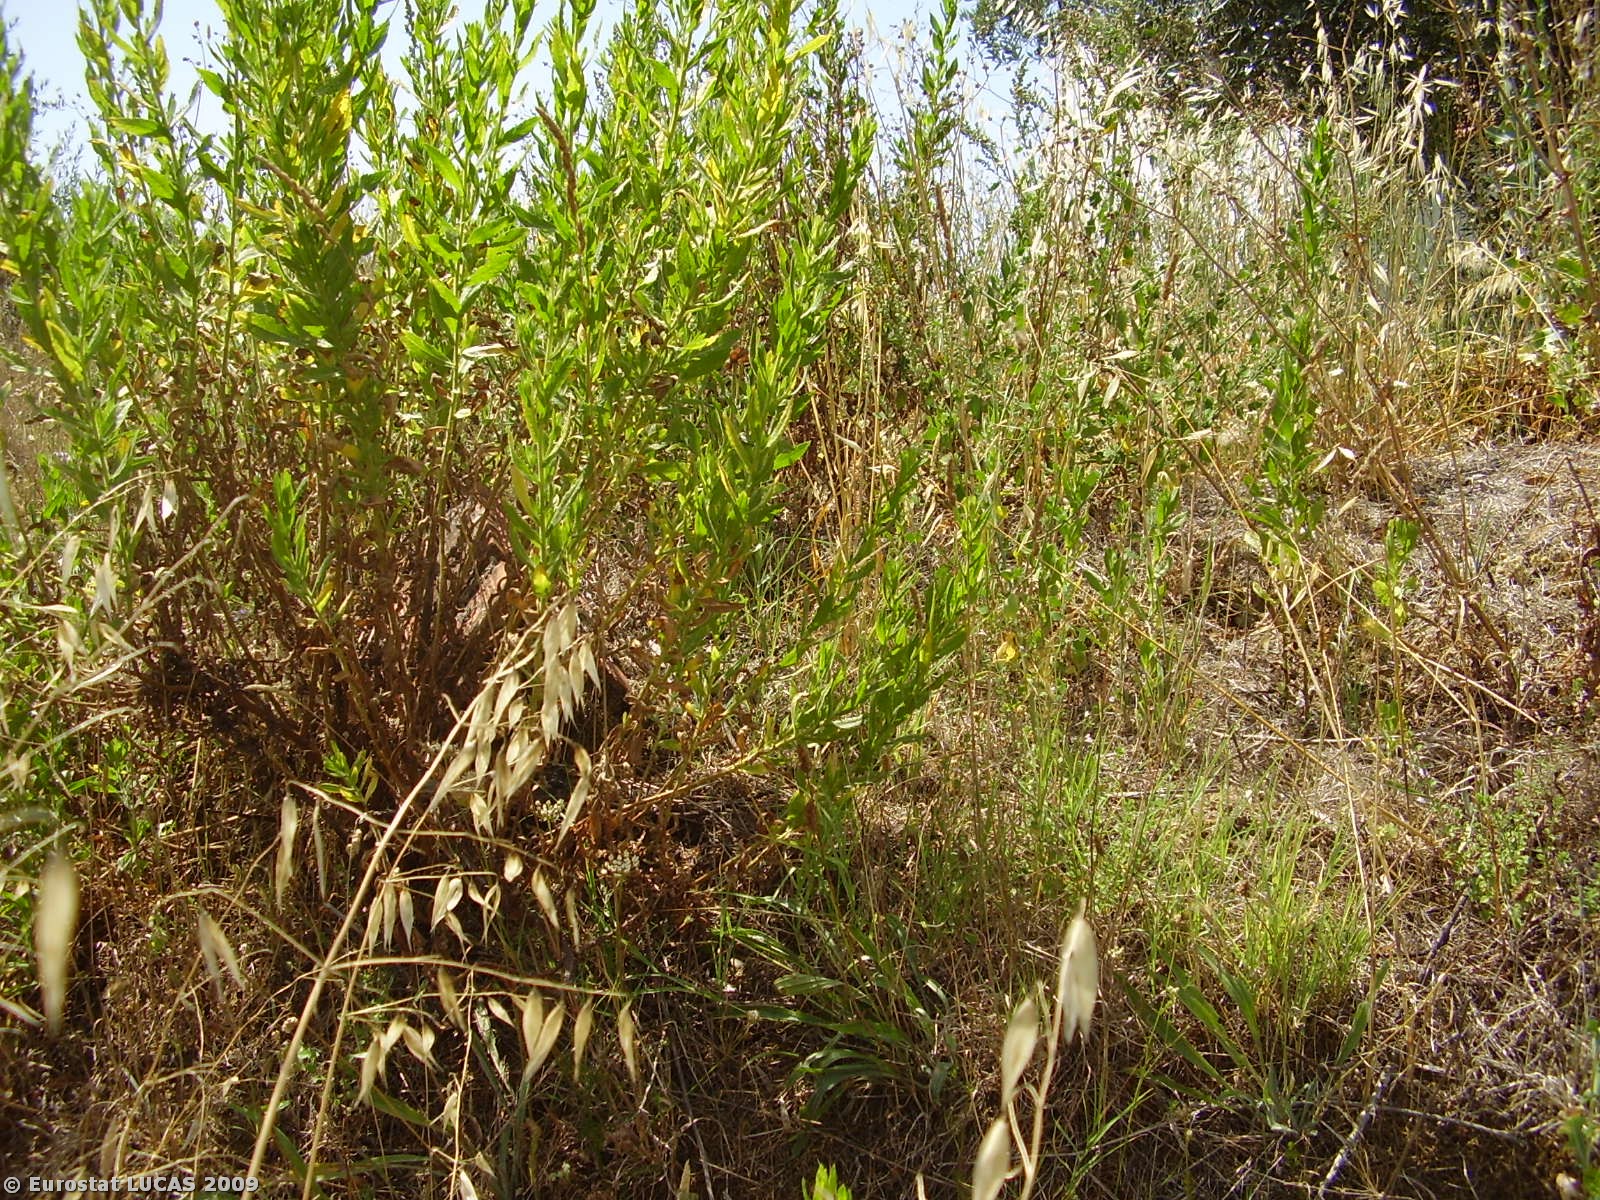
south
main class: Grassland
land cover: Spontaneously vegetated surfaces
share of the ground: > 75 %
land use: Fallow land
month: July
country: PT
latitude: 39.5502
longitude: -8.1843
